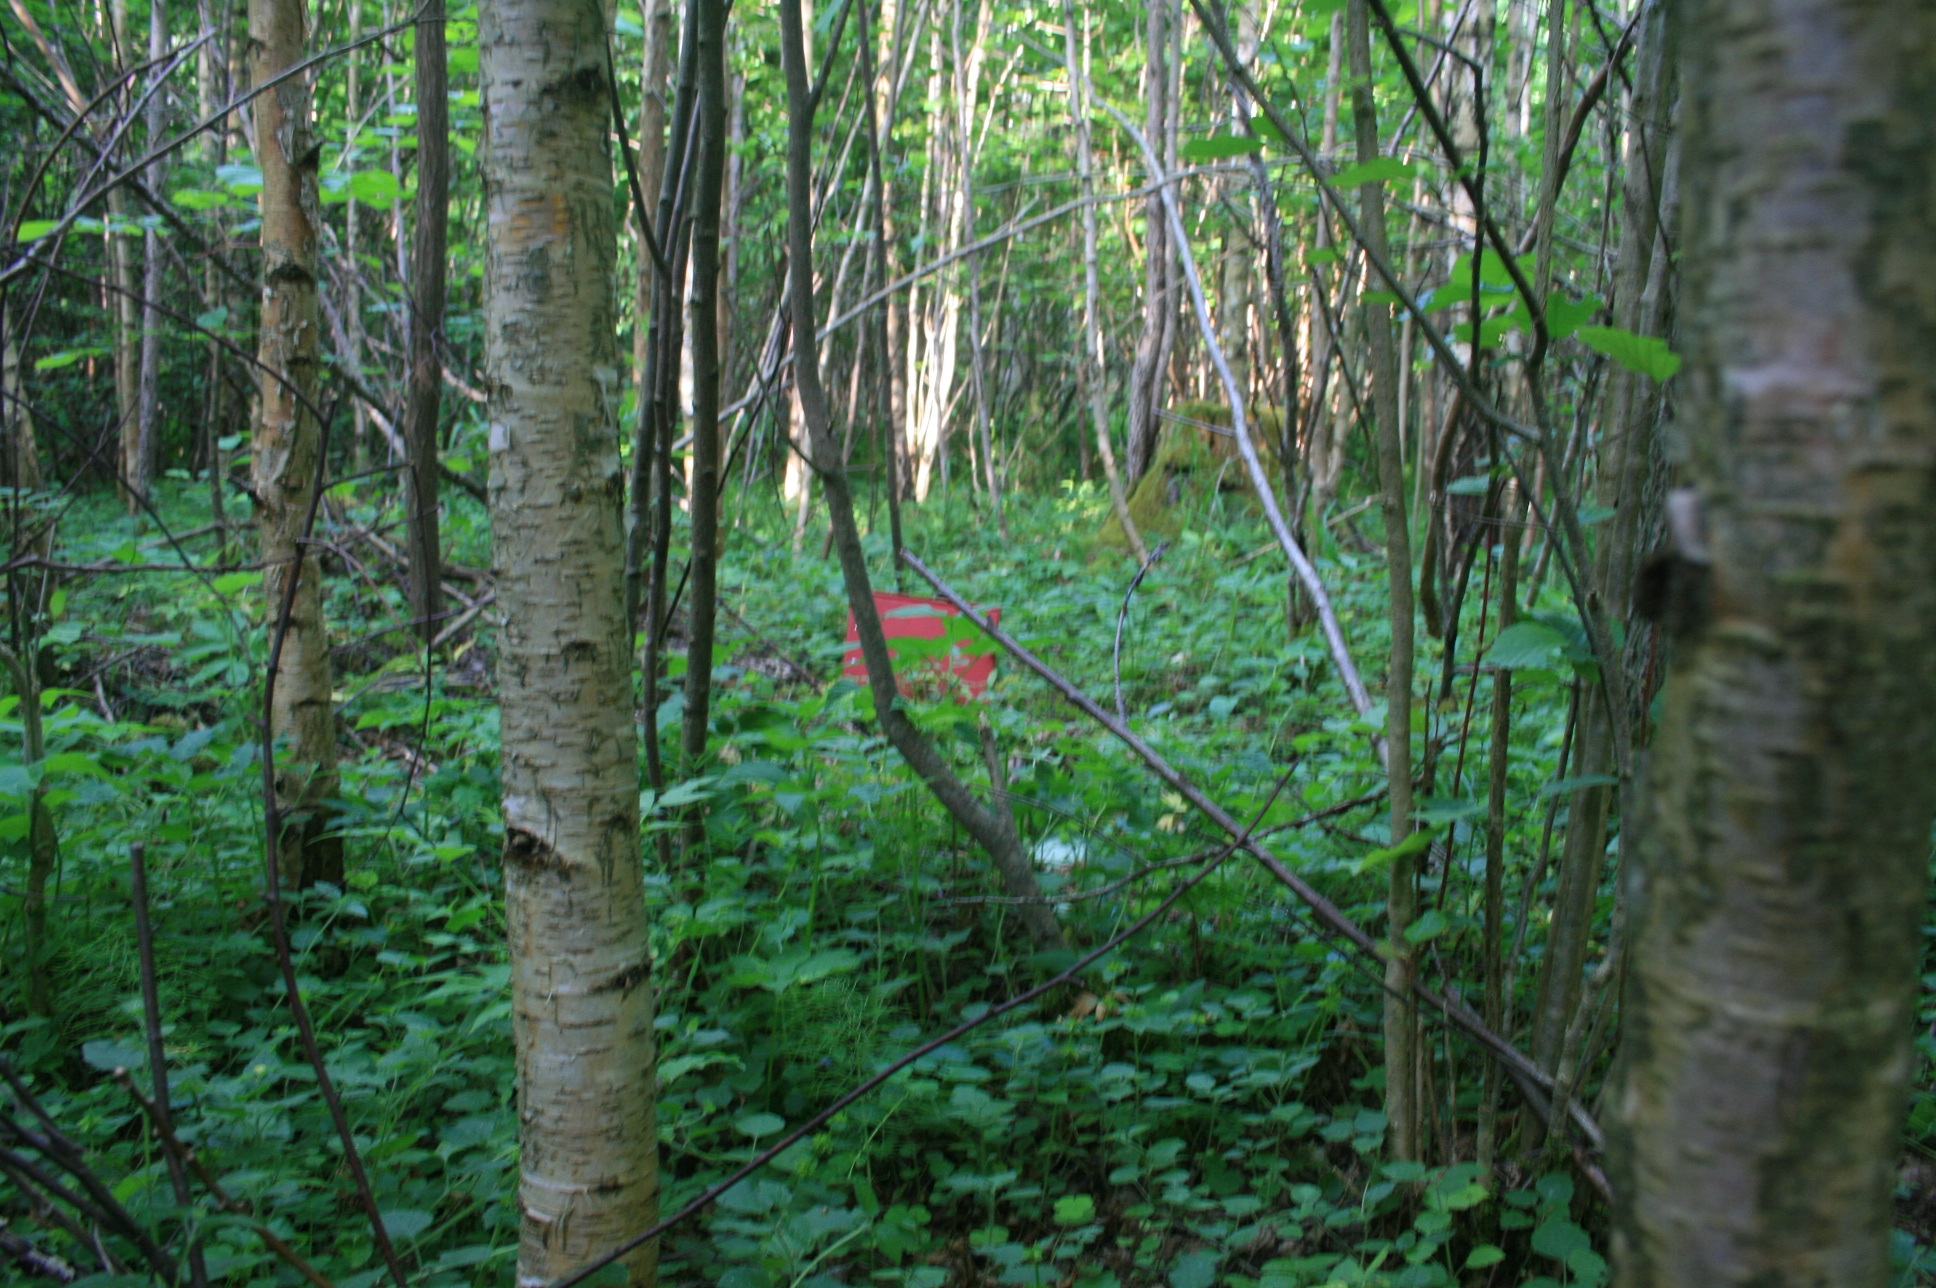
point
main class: Woodland
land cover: Broadleaved woodland
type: non-riverine alder, birch or aspen forest
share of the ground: > 75 %
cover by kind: broadleaved forest trees 95 %, herbaceous plants 5 %
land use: Forestry
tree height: > 5 m
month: June
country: LT
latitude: 55.7122
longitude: 22.1998
